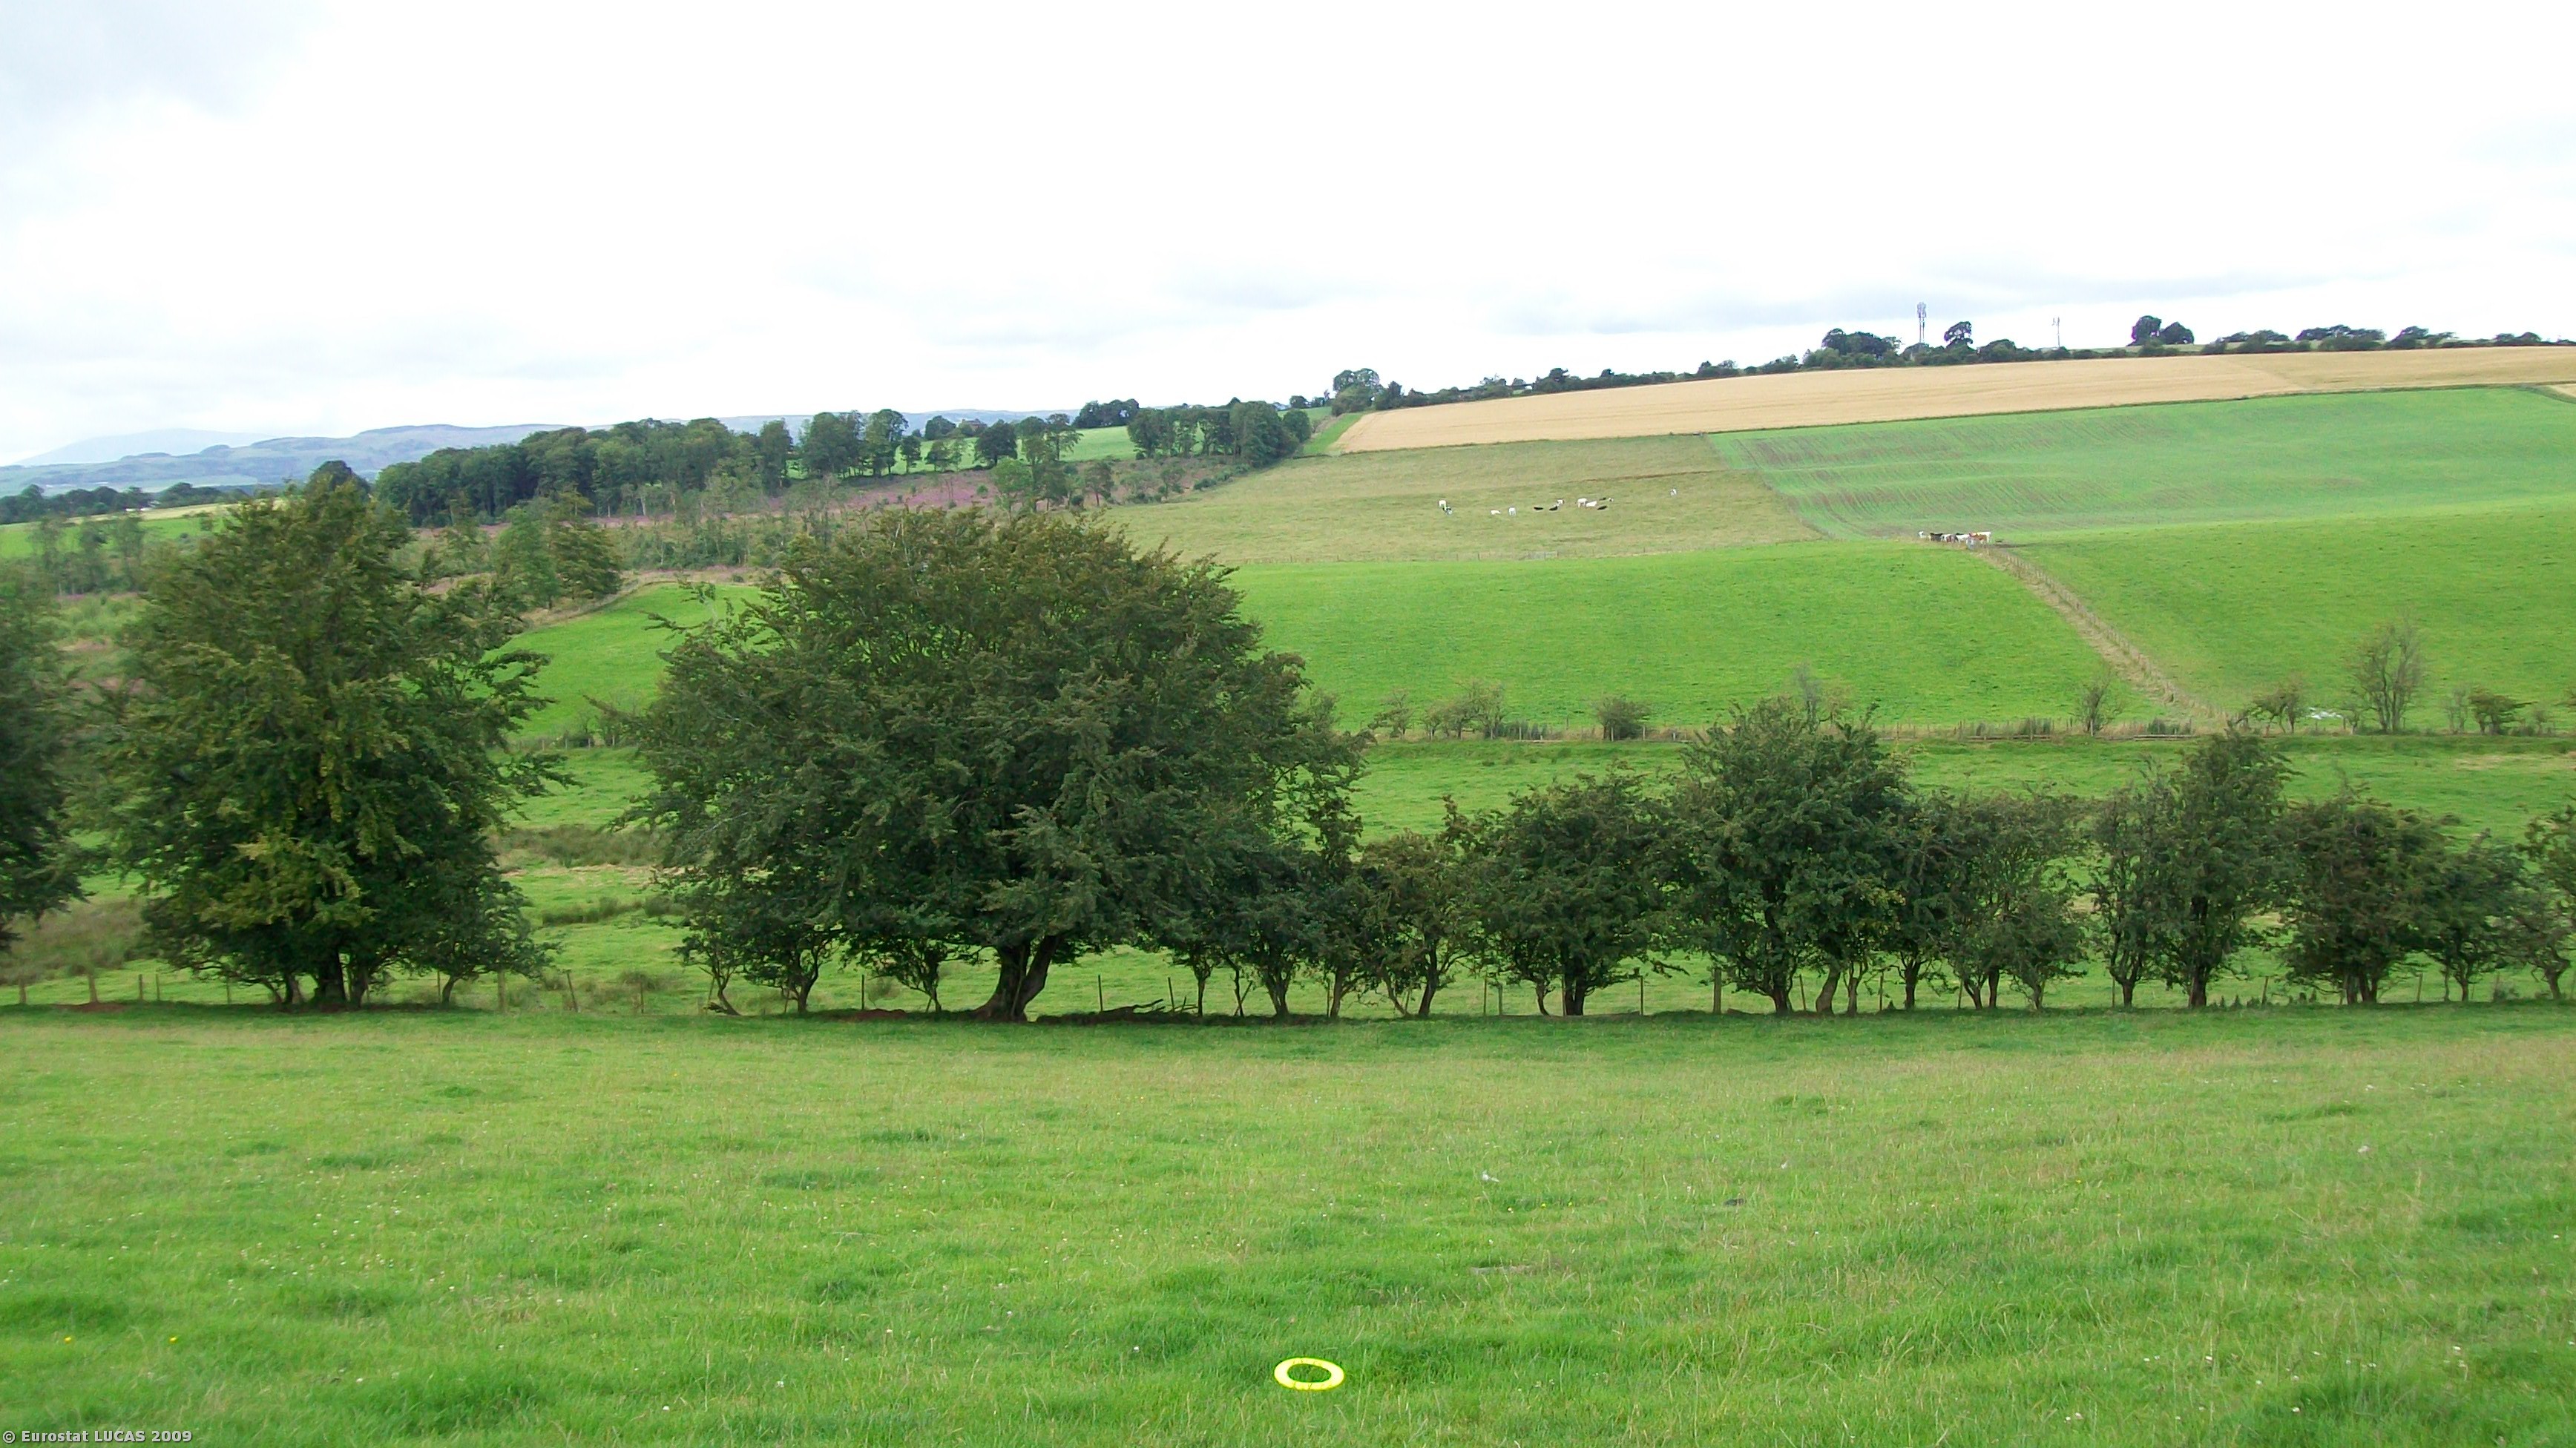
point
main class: Grassland
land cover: Grassland without tree/shrub cover
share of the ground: > 75 %
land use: Agriculture (excluding fallow land and kitchen gardens)
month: July
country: GB
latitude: 55.1234
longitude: -3.3276
